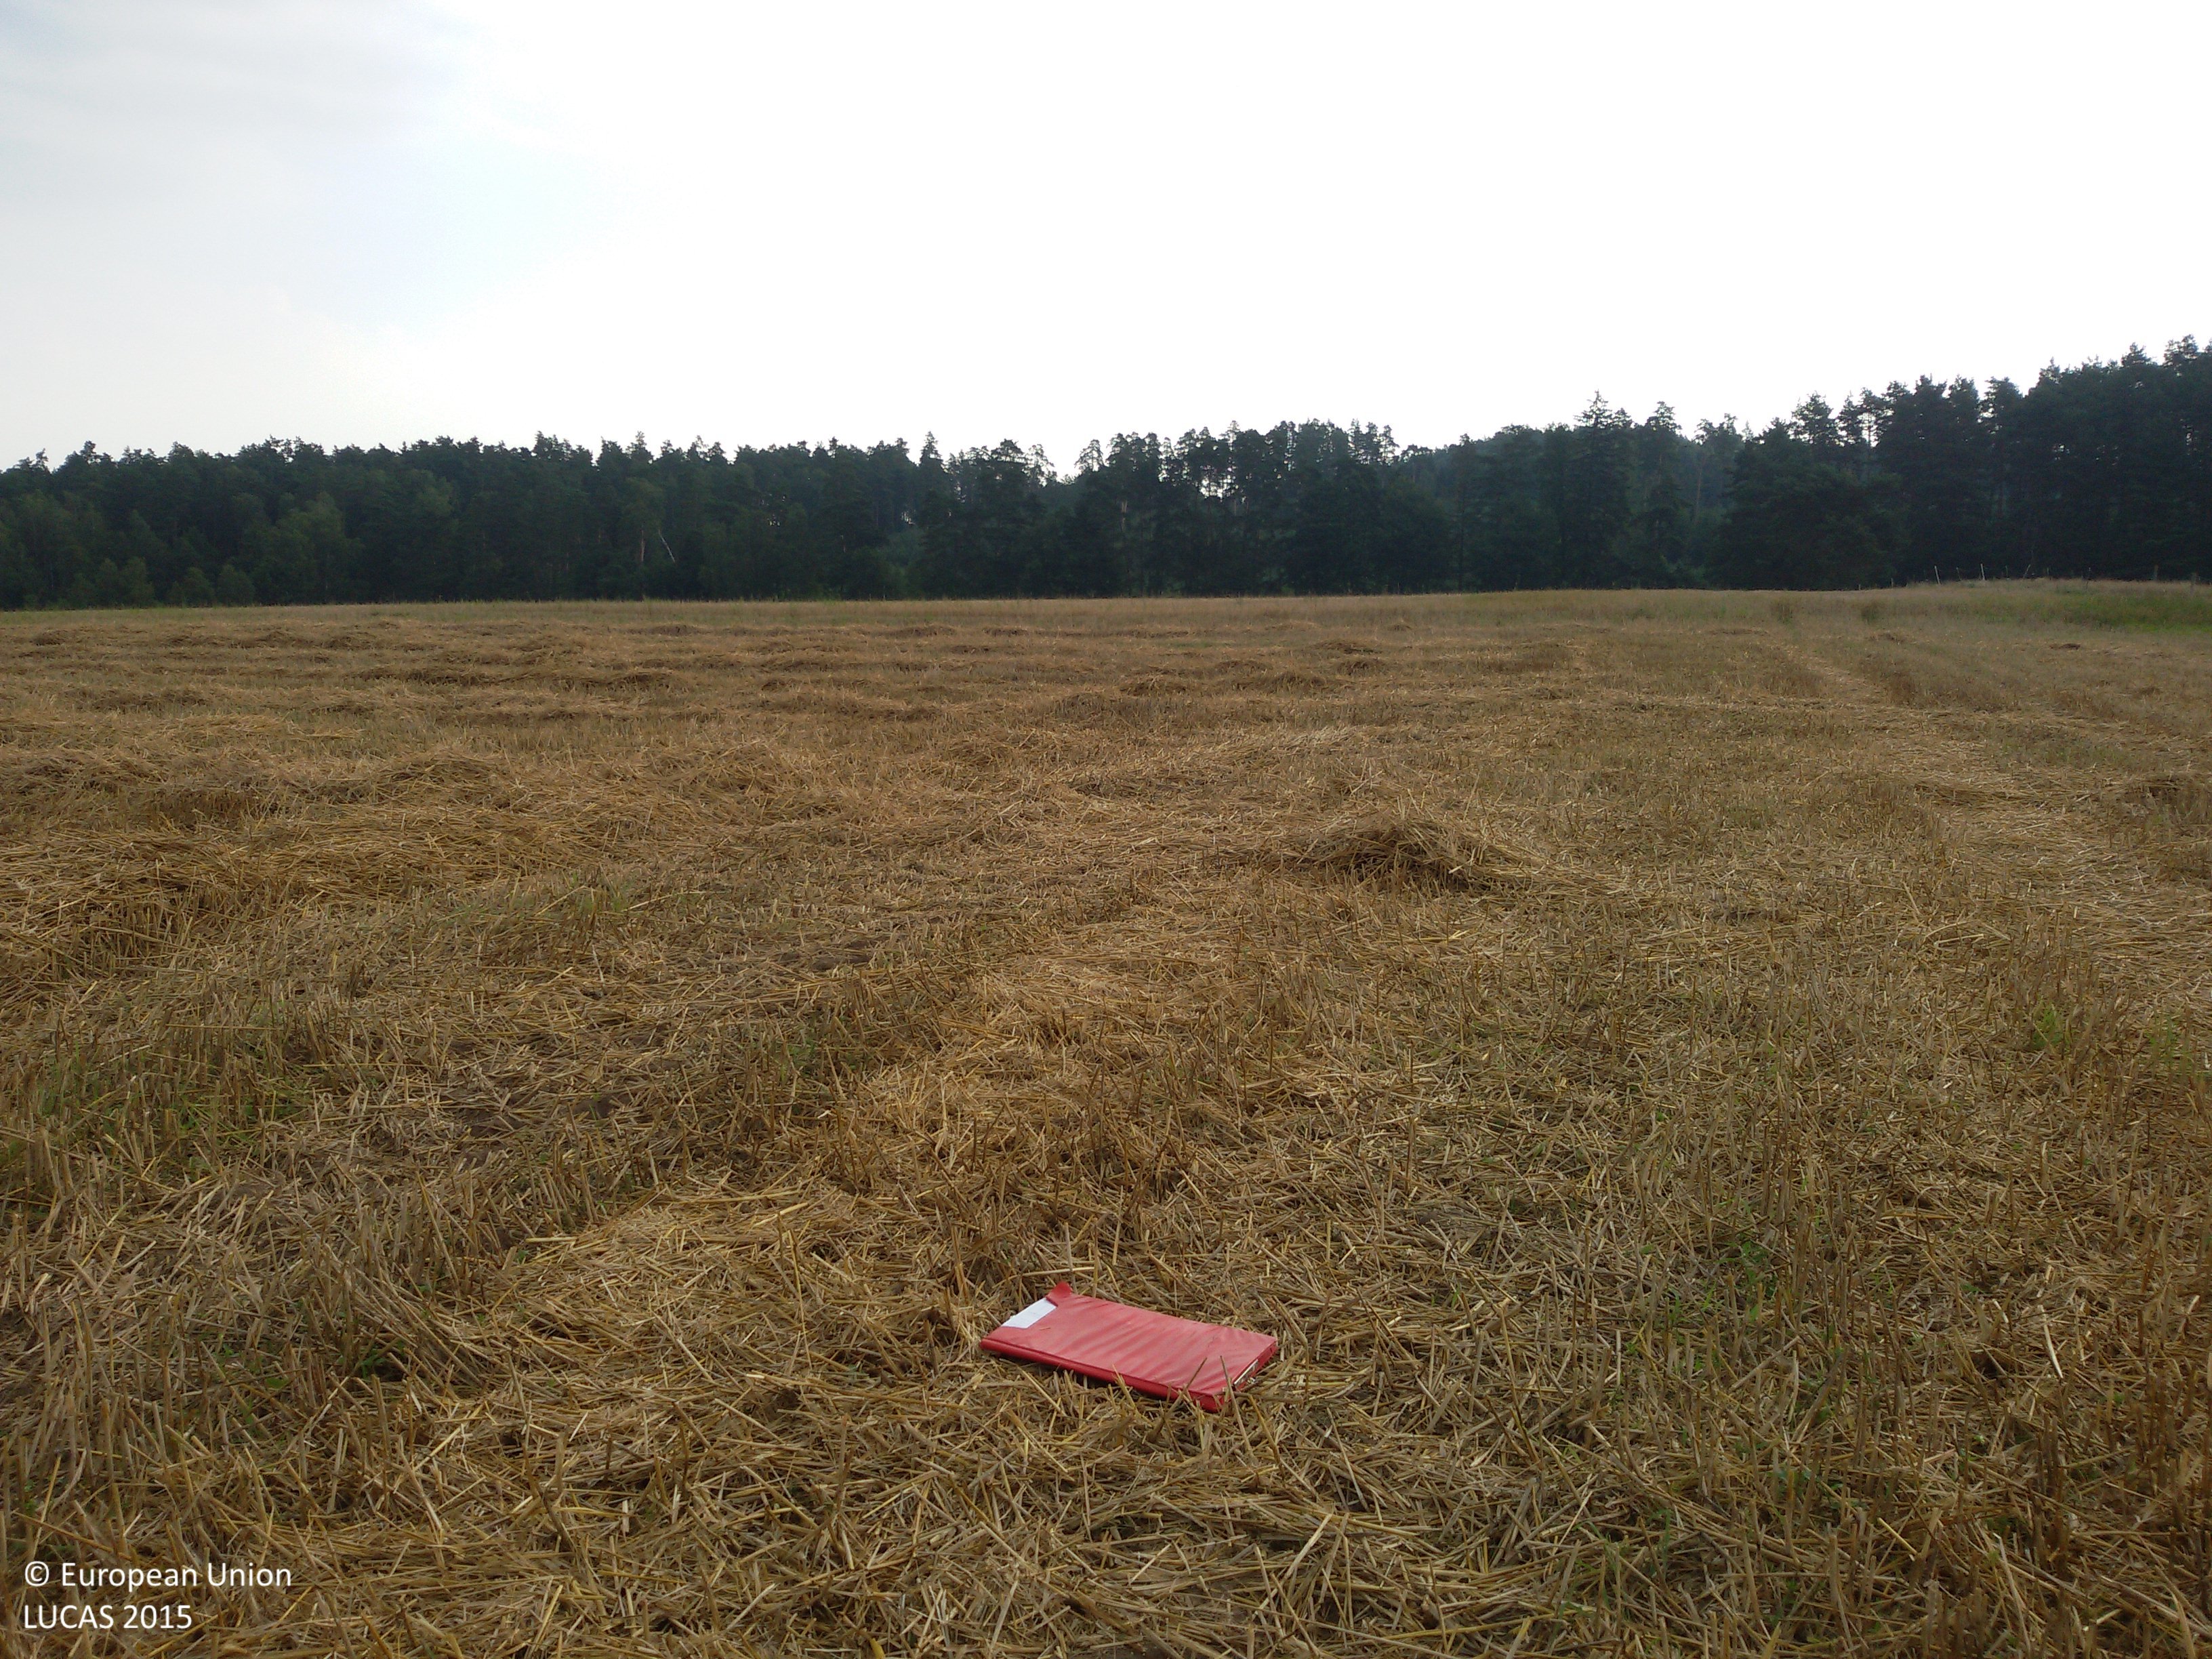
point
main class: Cropland
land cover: Triticale
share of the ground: 50 - 75 %
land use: Agriculture (excluding fallow land and kitchen gardens)
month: August
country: PL
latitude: 54.2860
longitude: 17.2445
